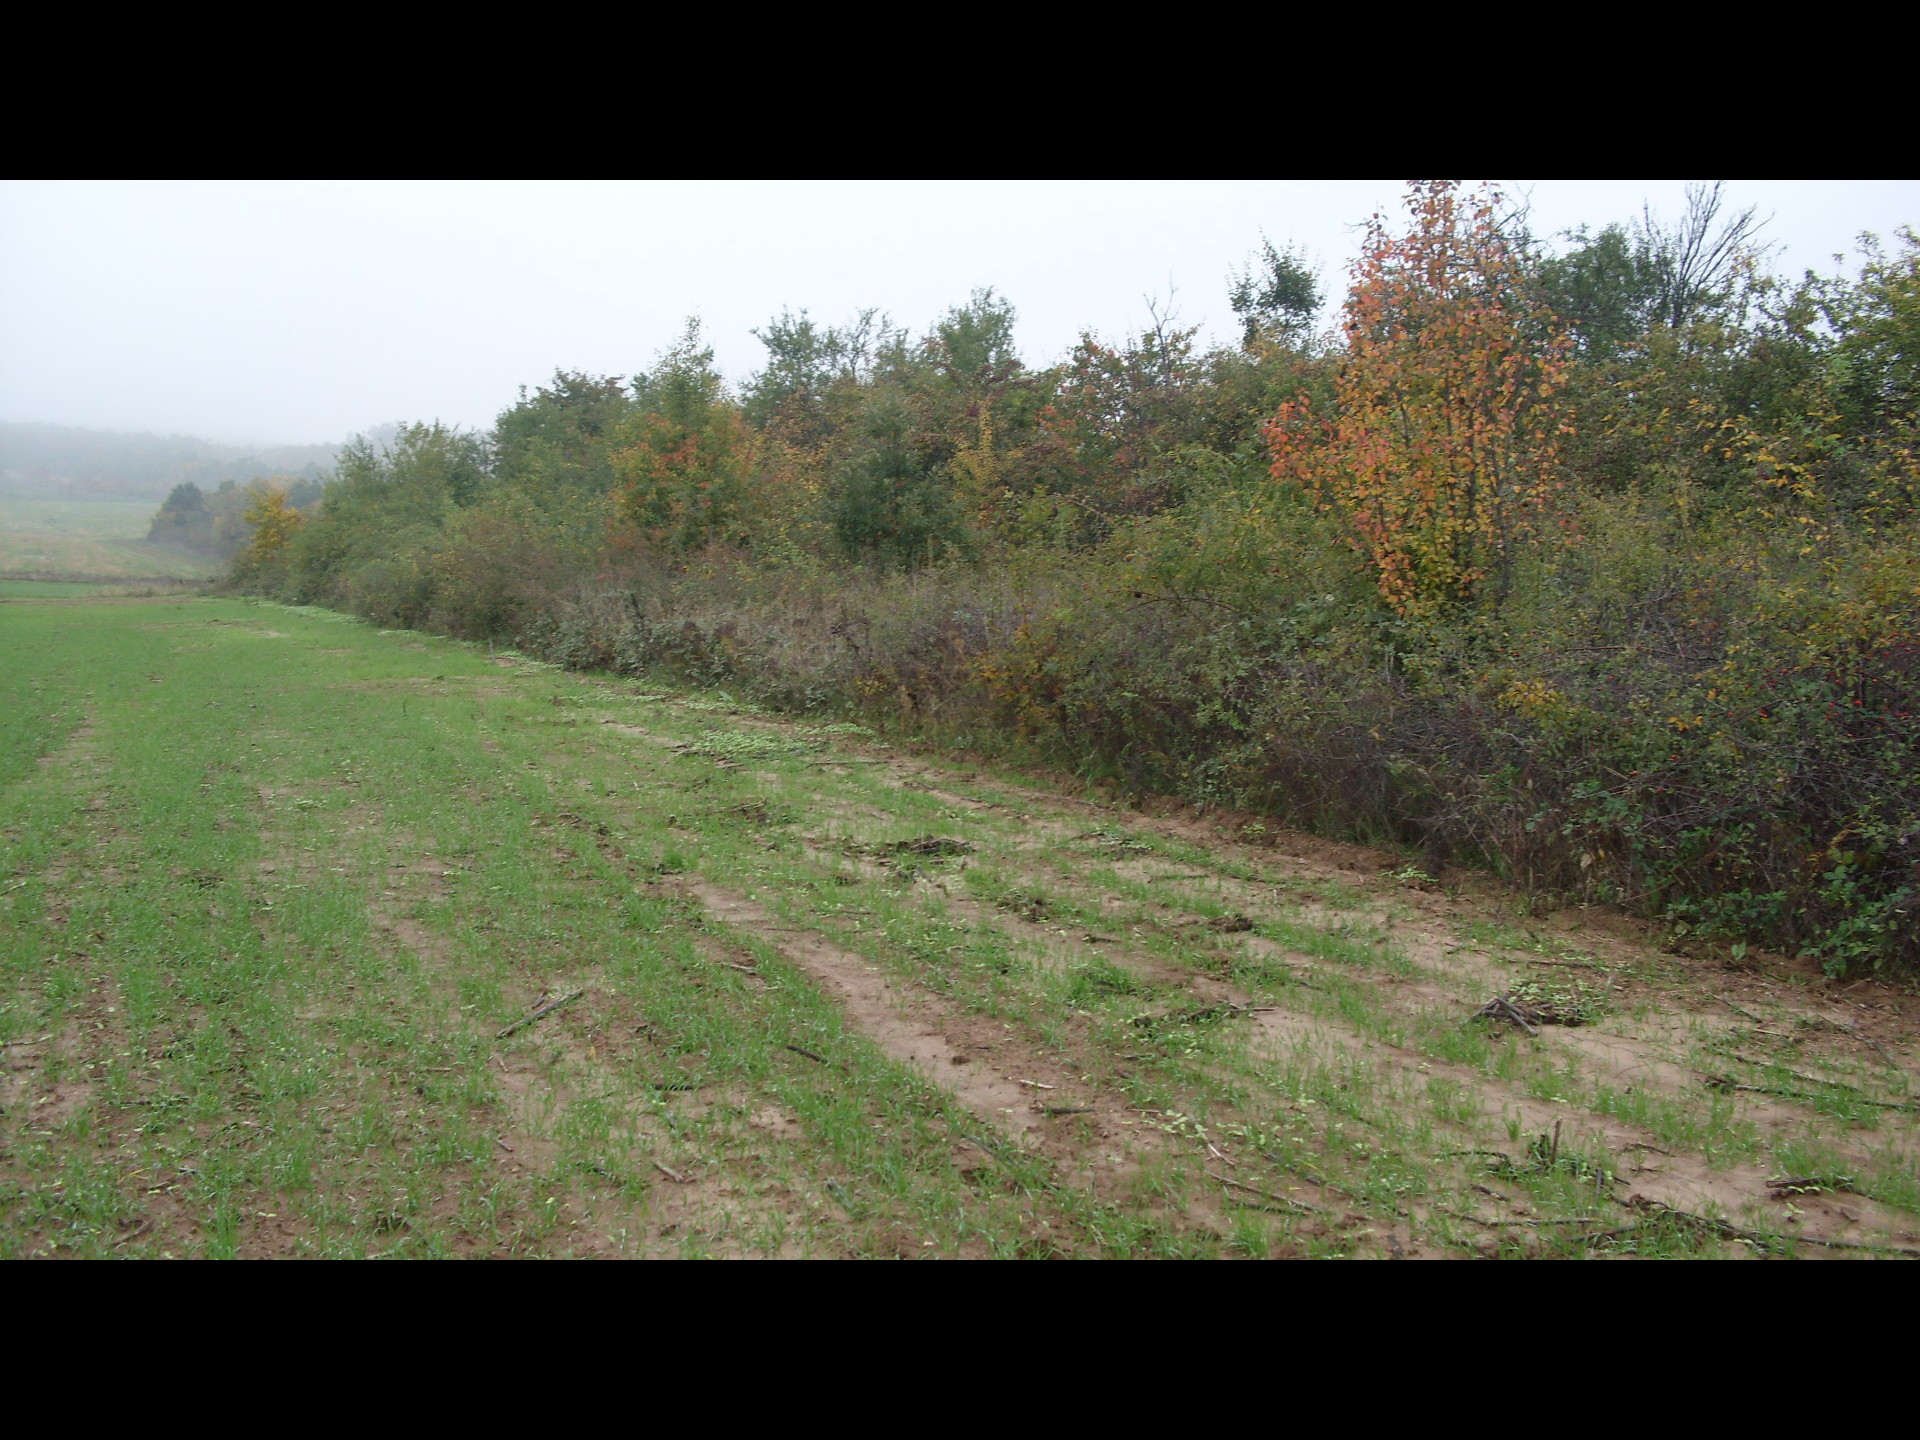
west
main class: Cropland
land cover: Pear fruit
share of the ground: 50 - 75 %
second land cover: Spontaneously vegetated surfaces
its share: > 75 %
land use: Abandoned areas
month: October
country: BG
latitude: 43.5484
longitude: 22.8460
